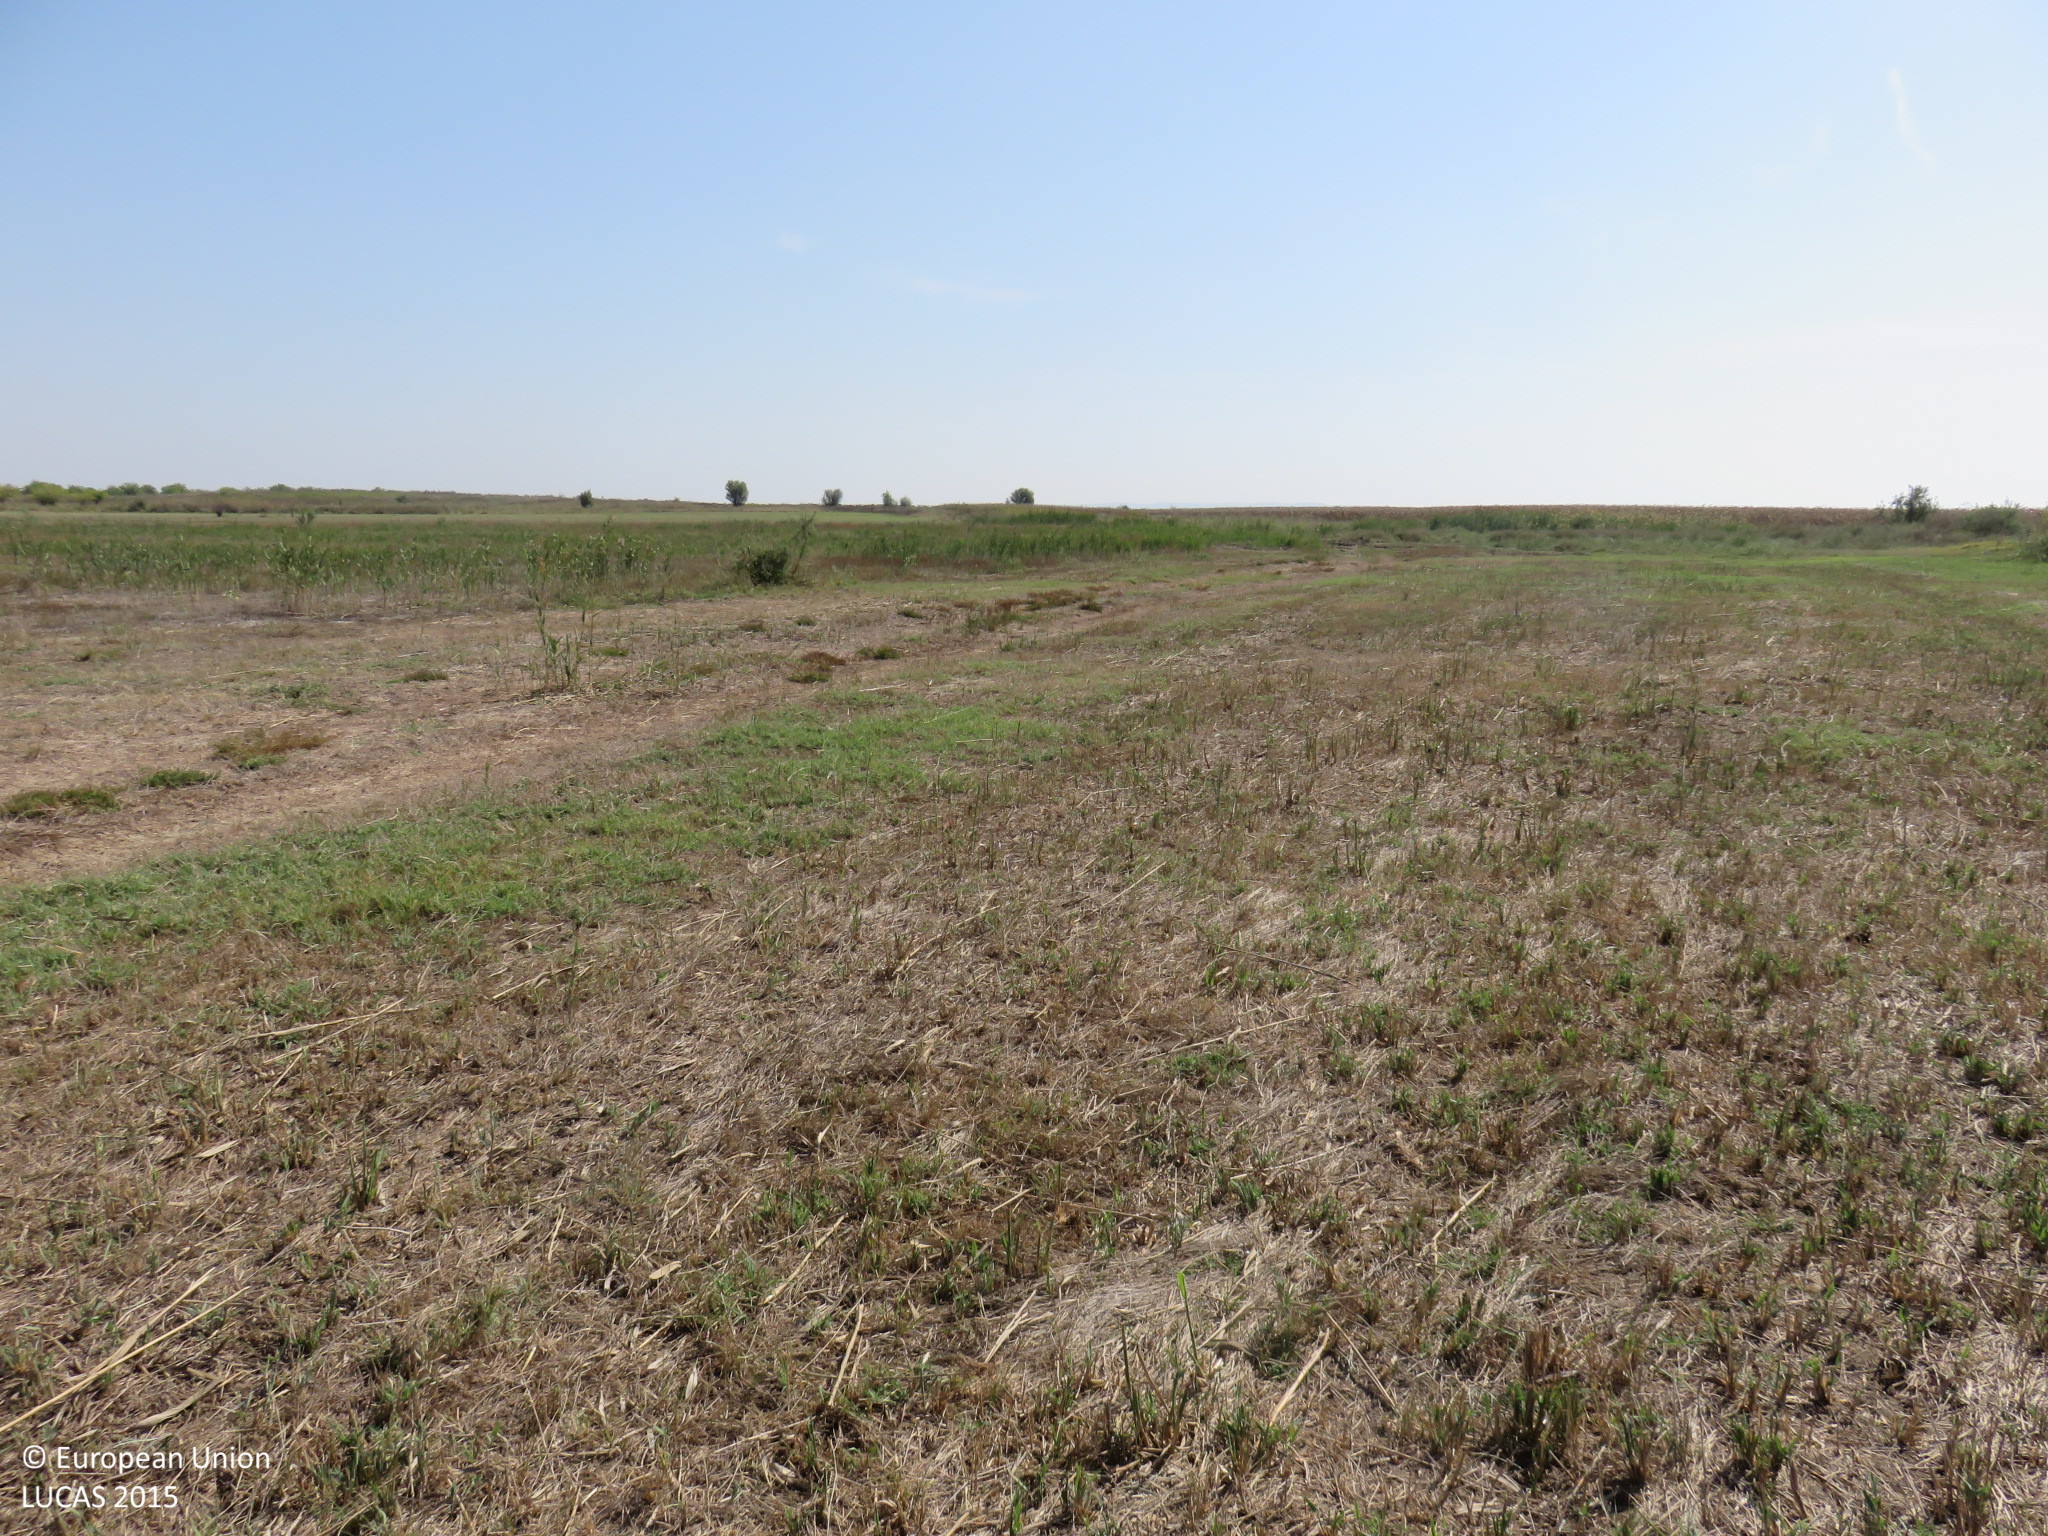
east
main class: Grassland
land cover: Grassland without tree/shrub cover
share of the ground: > 75 %
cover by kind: herbaceous plants 100 %
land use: Agriculture (excluding fallow land and kitchen gardens)
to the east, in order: Grassland without tree/shrub cover; Tracks; Grassland without tree/shrub cover; Tracks; Grassland without tree/shrub cover
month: September
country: BG
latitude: 43.7177
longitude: 24.5750
